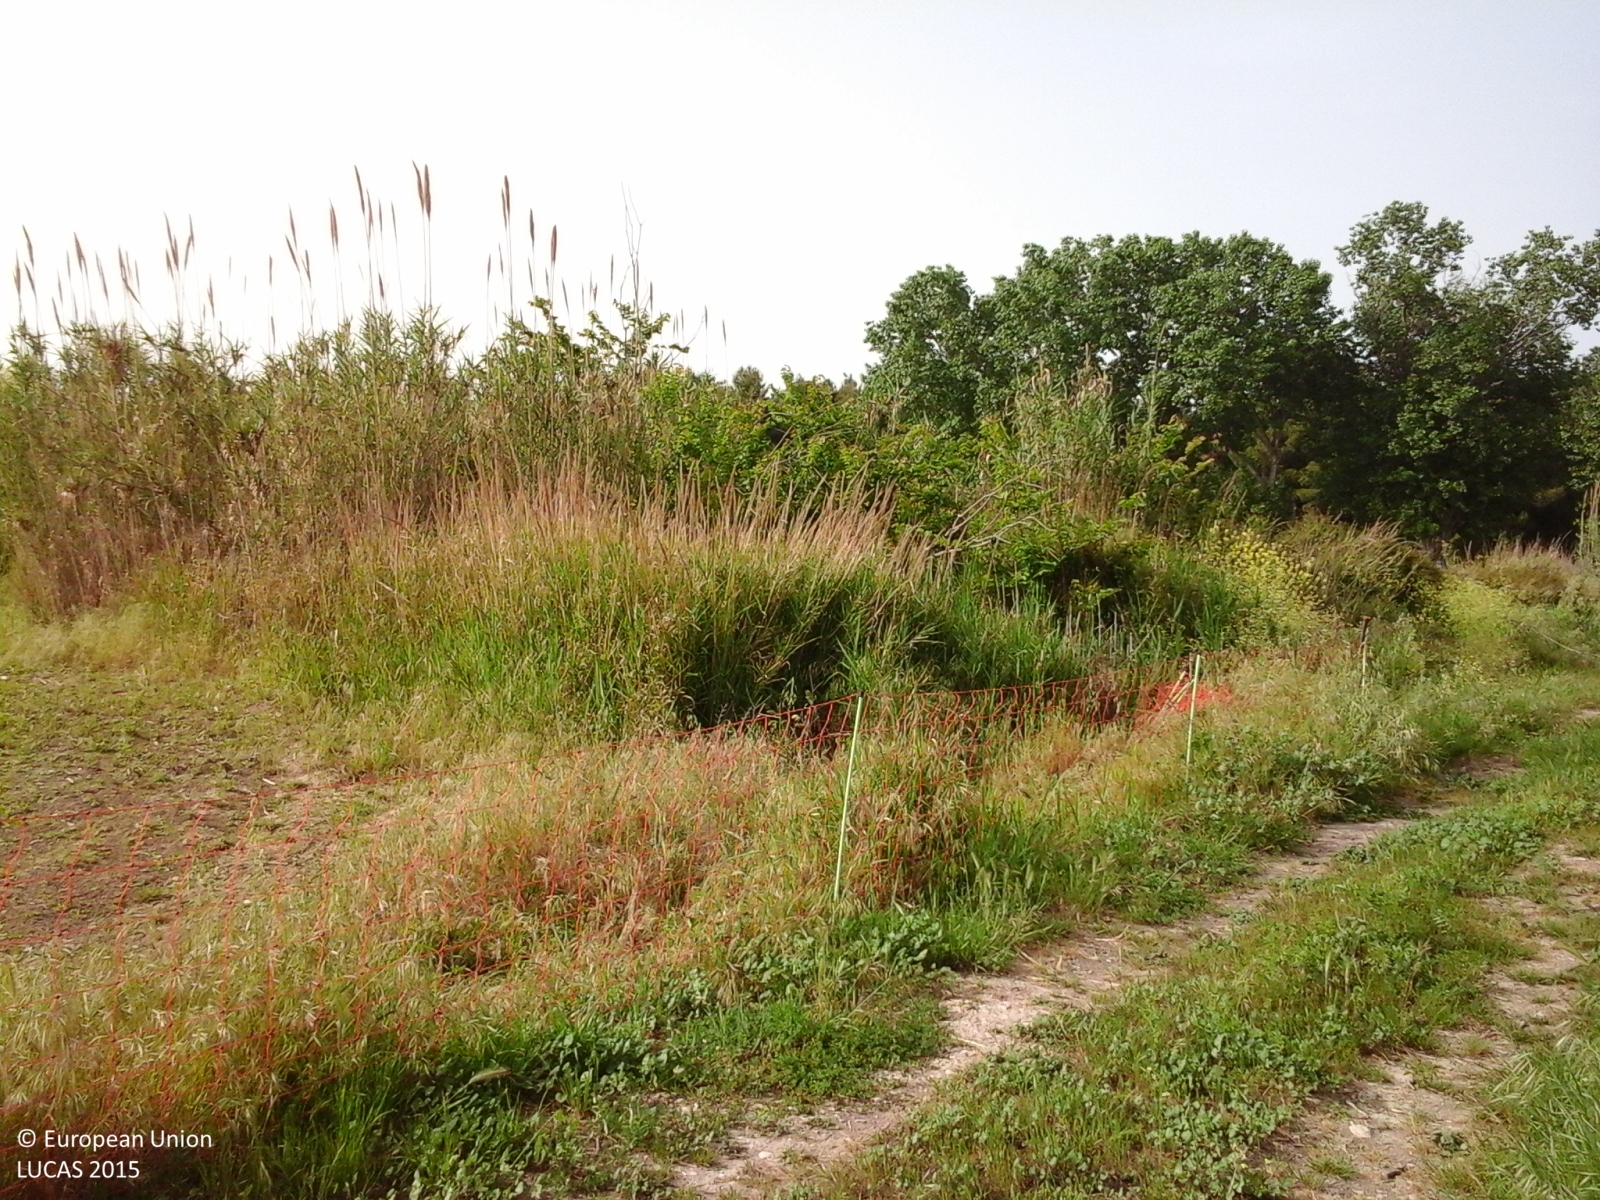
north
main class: Cropland
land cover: Durum wheat
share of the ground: > 75 %
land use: Agriculture (excluding fallow land and kitchen gardens)
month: May
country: IT
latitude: 42.0717
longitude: 14.7596
